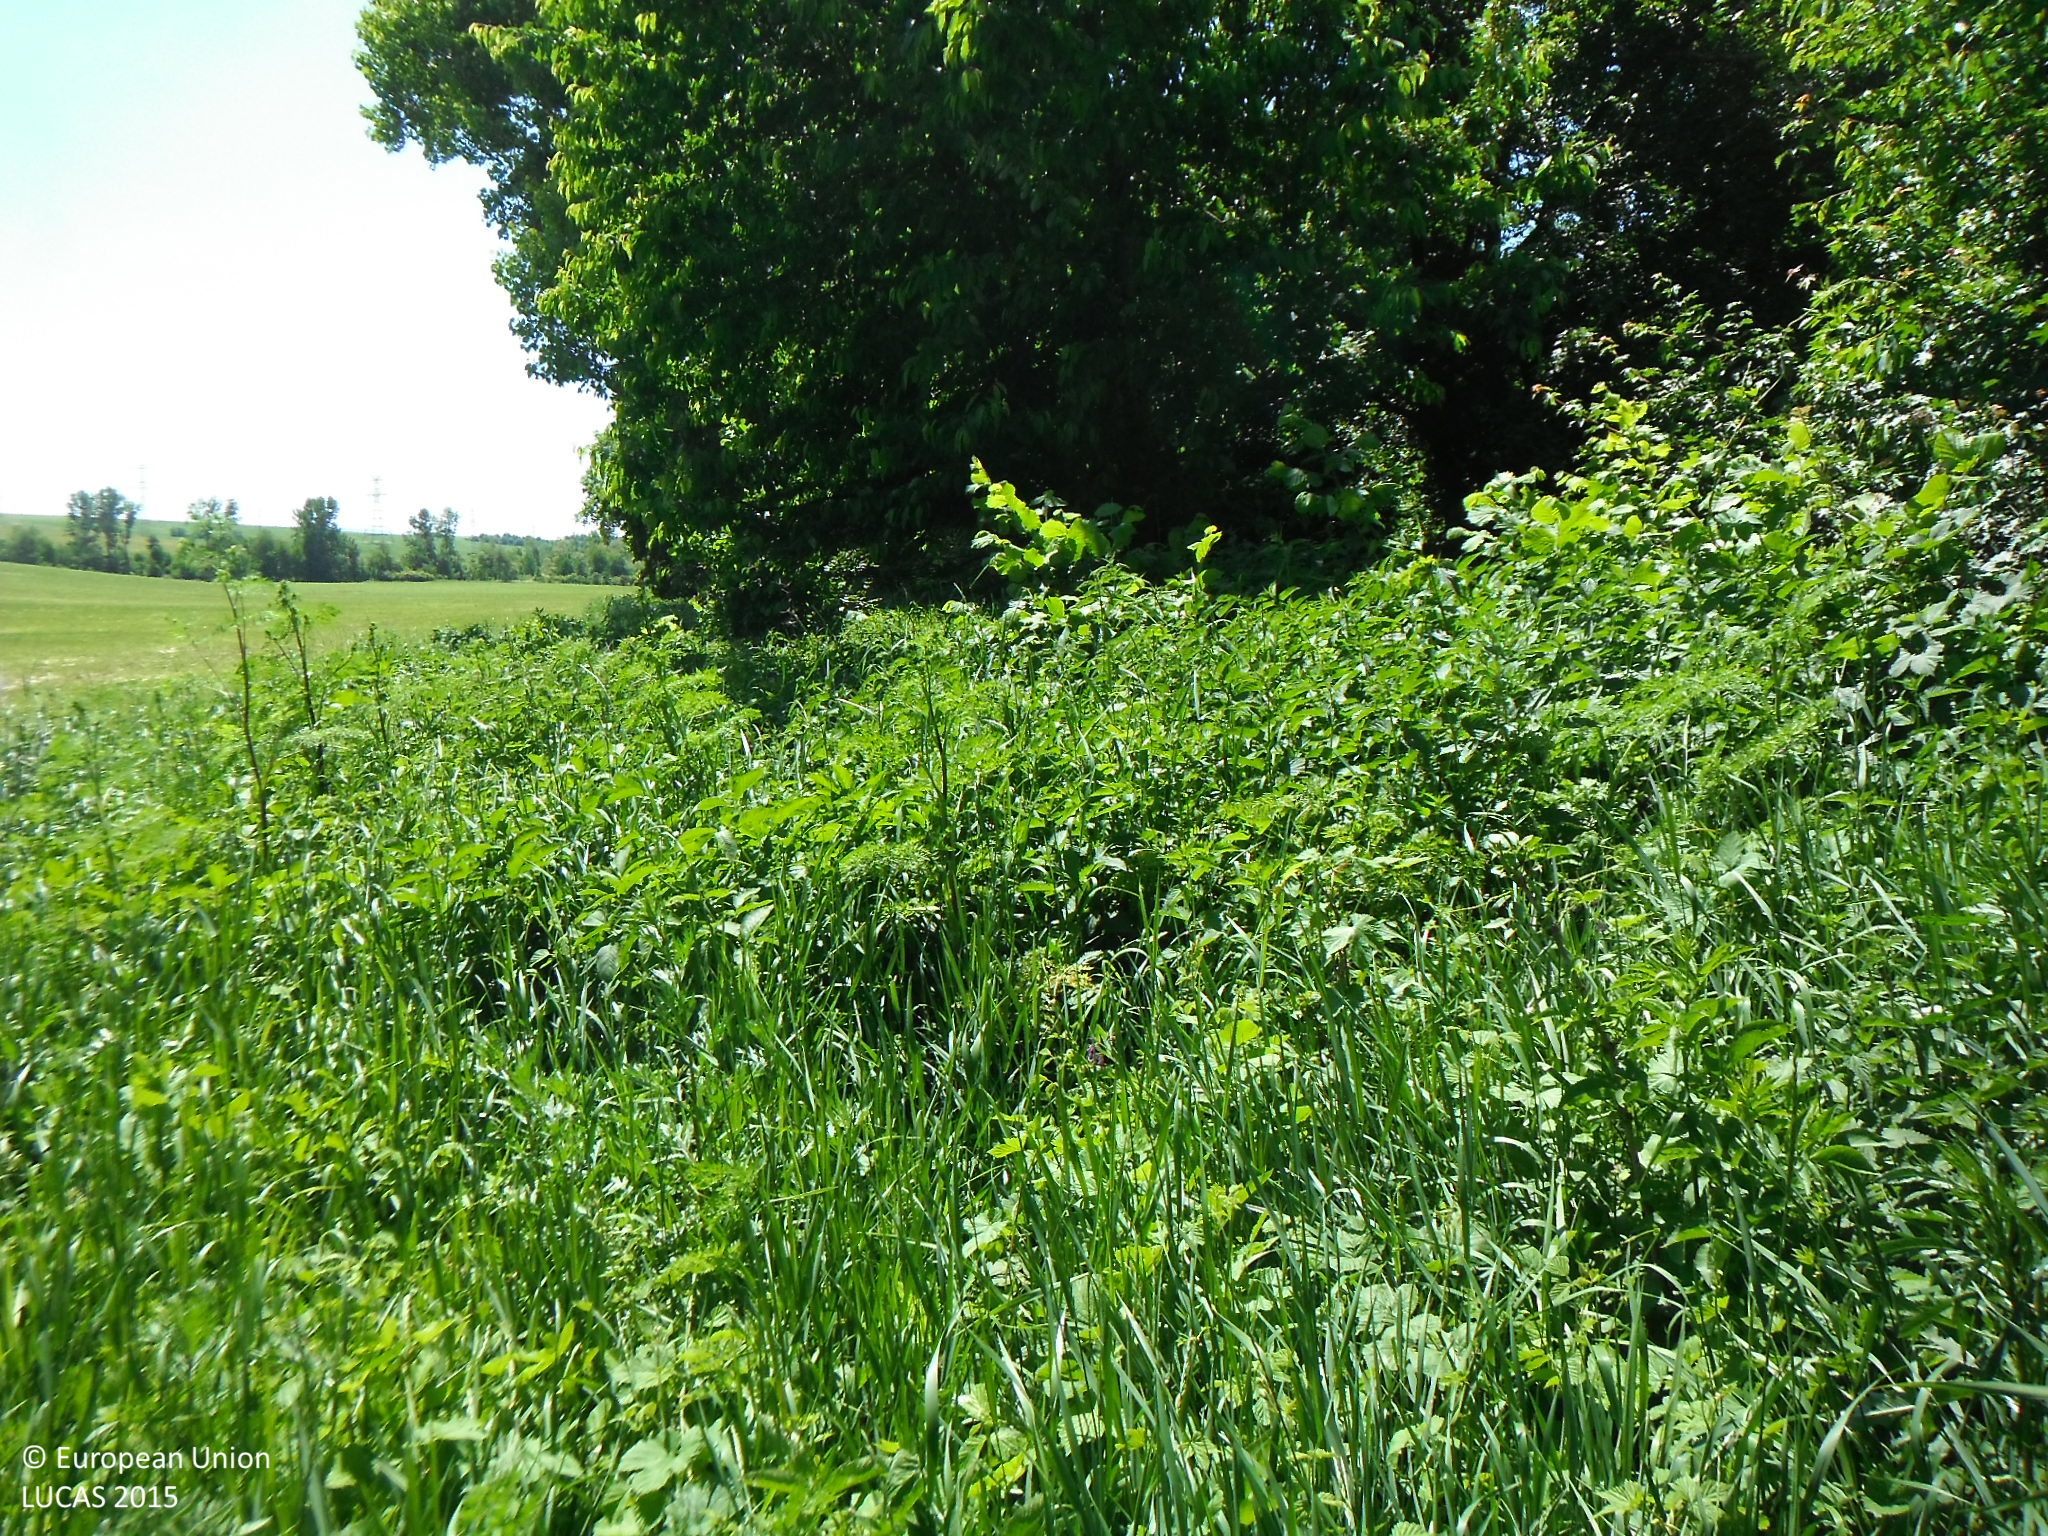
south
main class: Grassland
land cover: Spontaneously vegetated surfaces
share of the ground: > 75 %
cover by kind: herbaceous plants 100 %
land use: Semi-natural and natural areas not in use
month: June
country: SK
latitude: 48.8736
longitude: 21.3213
